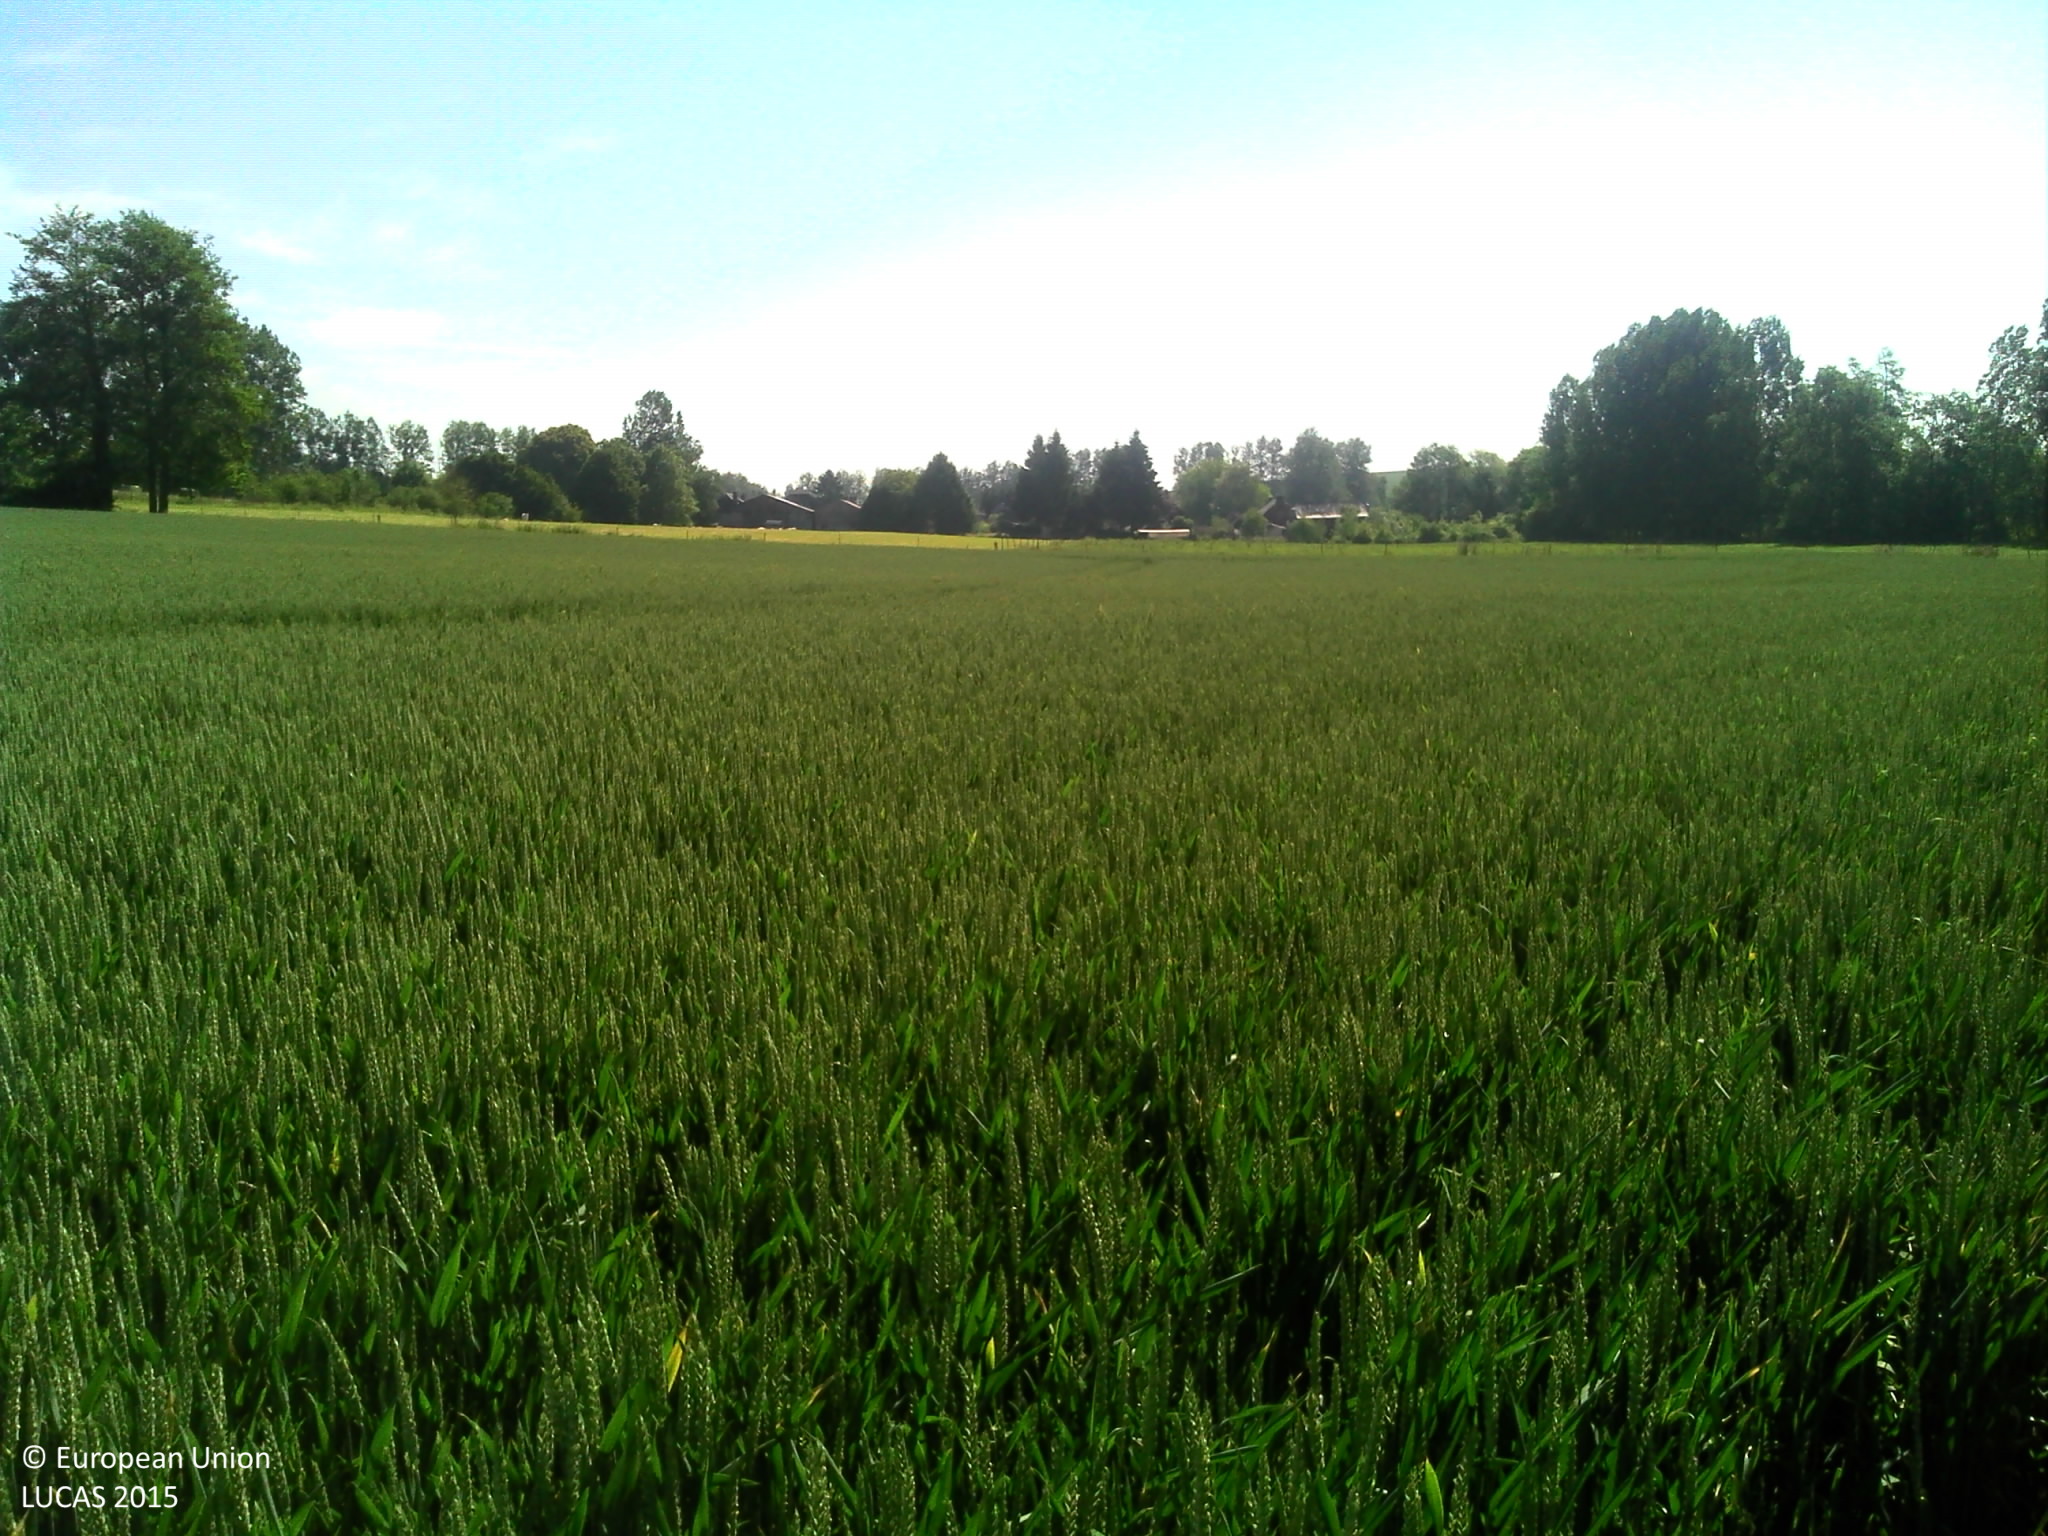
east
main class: Cropland
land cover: Common wheat
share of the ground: > 75 %
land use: Agriculture (excluding fallow land and kitchen gardens)
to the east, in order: Grass margins; Common wheat; Grassland without tree/shrub cover; Fences; Grassland without tree/shrub cover
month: June
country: FR
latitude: 49.7758
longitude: 4.0374
